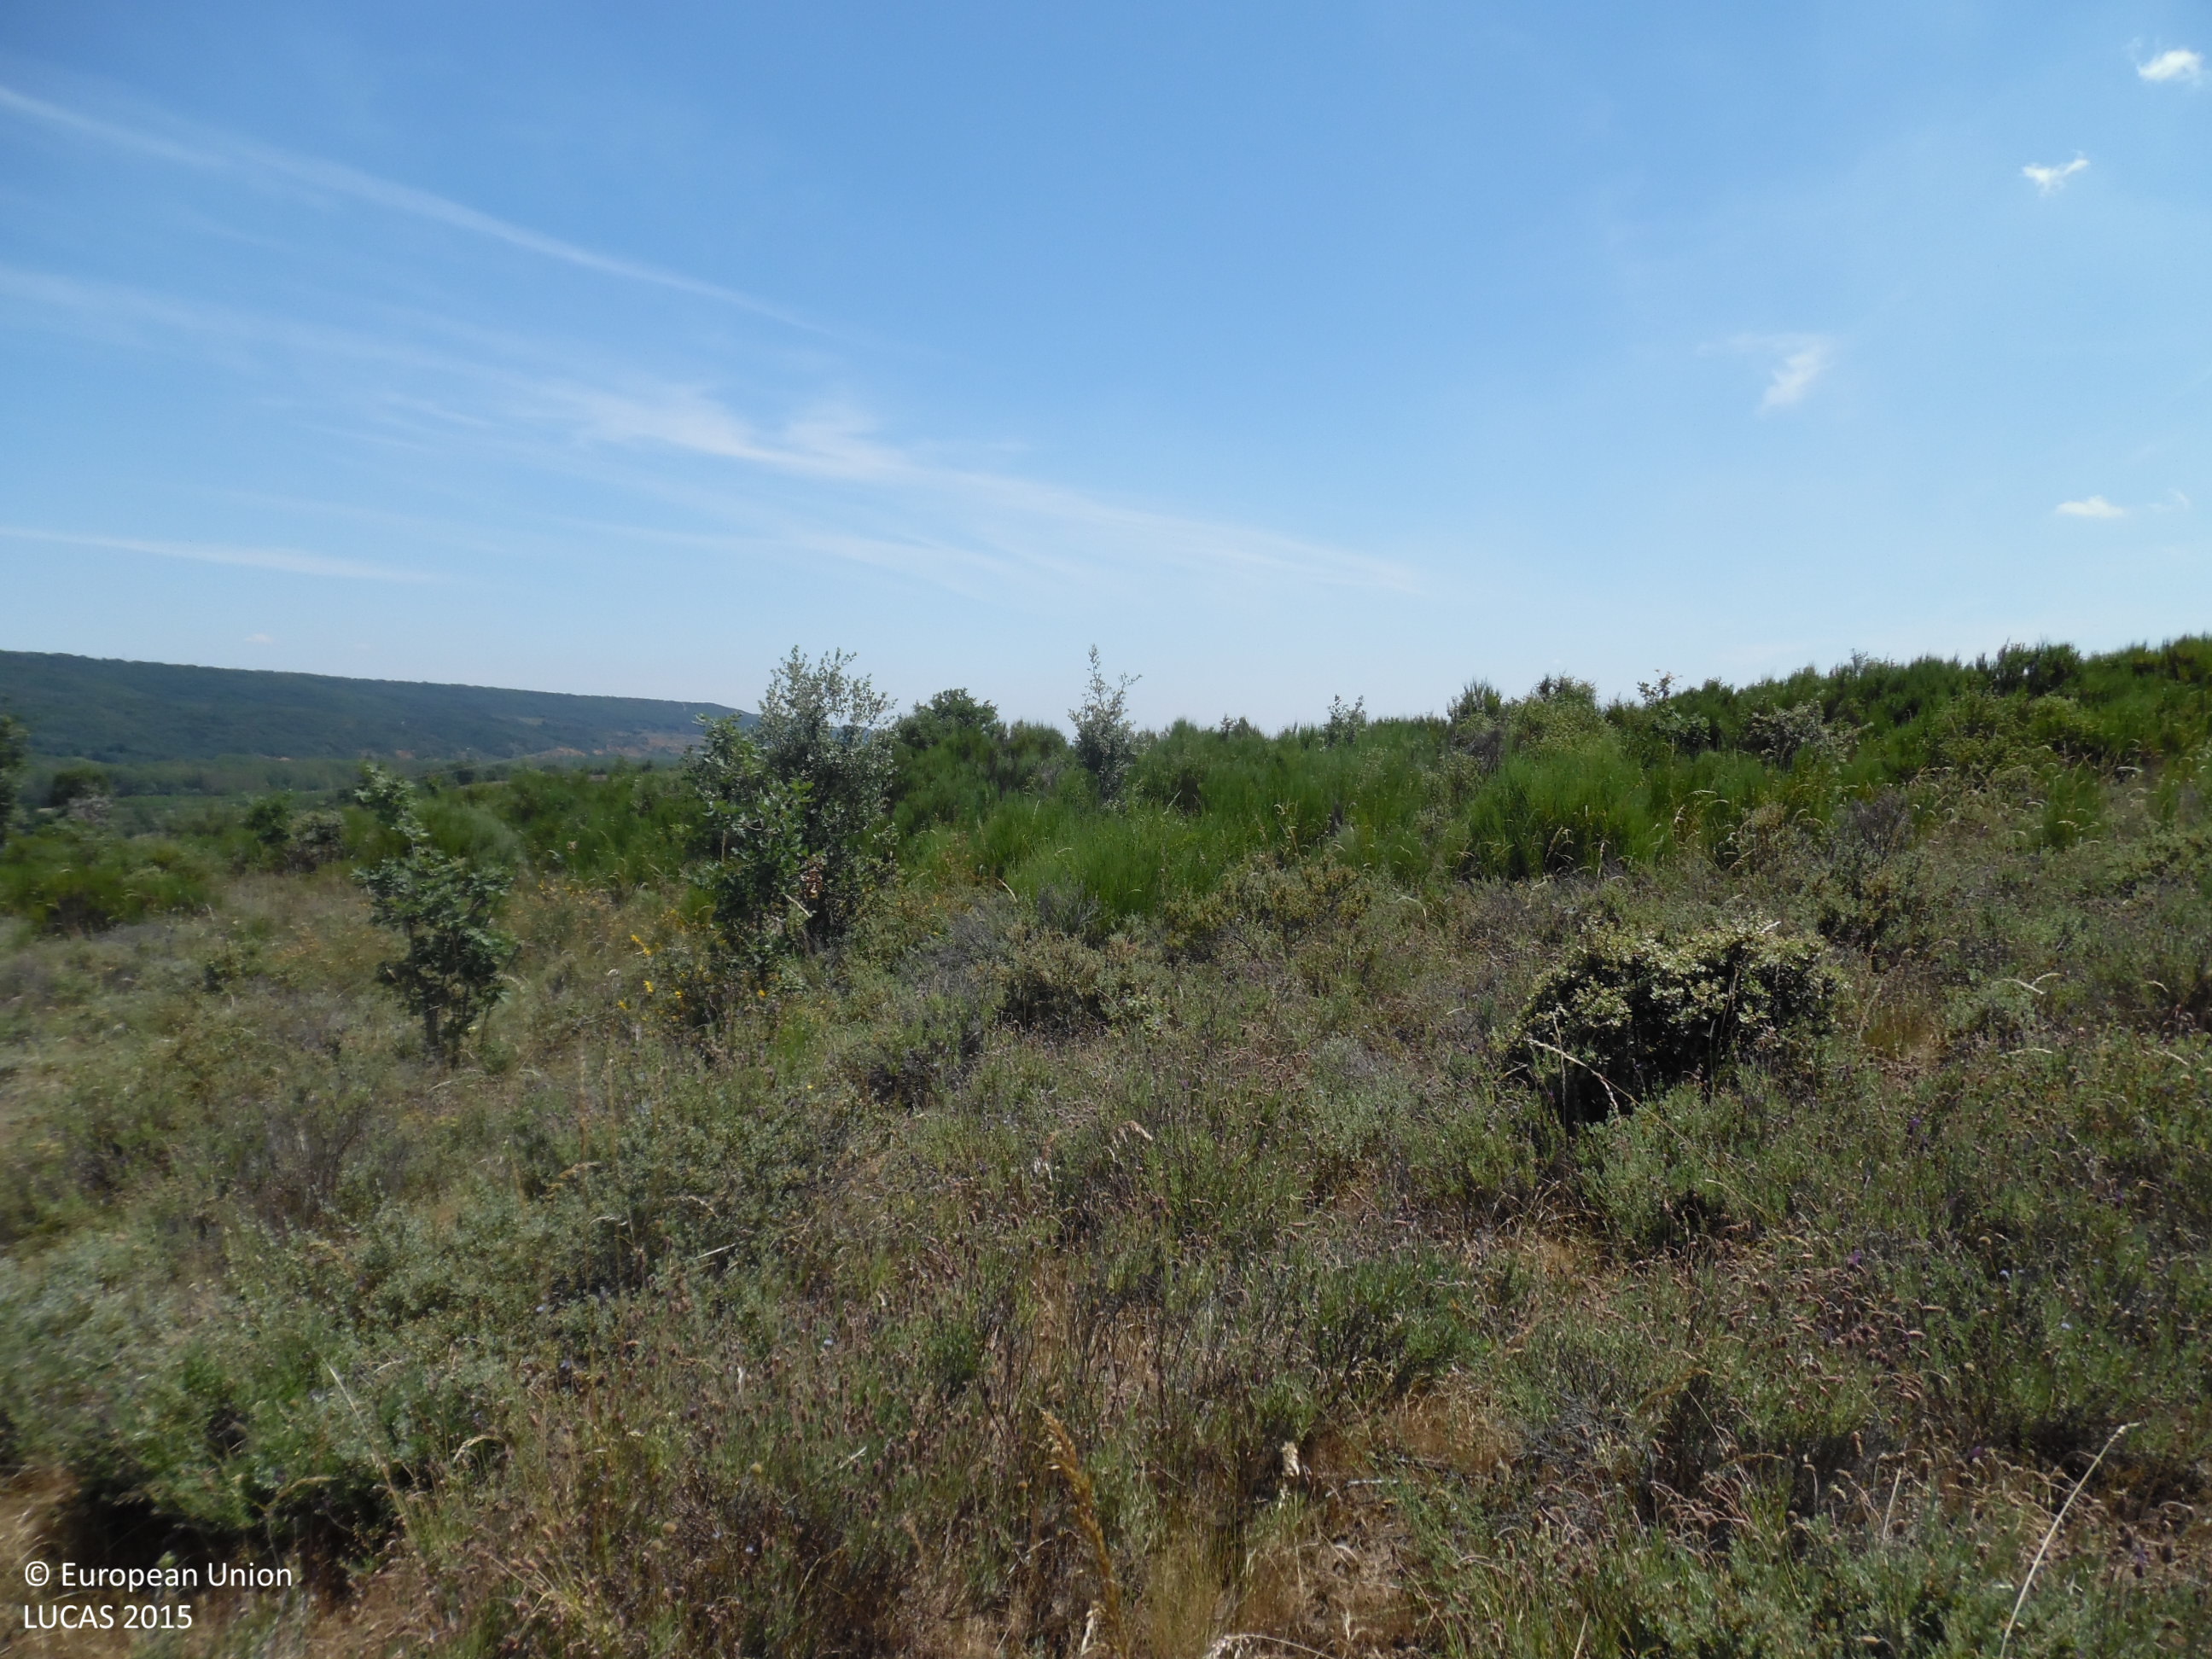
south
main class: Shrubland
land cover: Shrubland without tree cover
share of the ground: > 75 %
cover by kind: shrubs 95 %, herbaceous plants 5 %
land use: Semi-natural and natural areas not in use
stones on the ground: 10 - 25 %
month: June
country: ES
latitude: 42.7324
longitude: -5.6487
